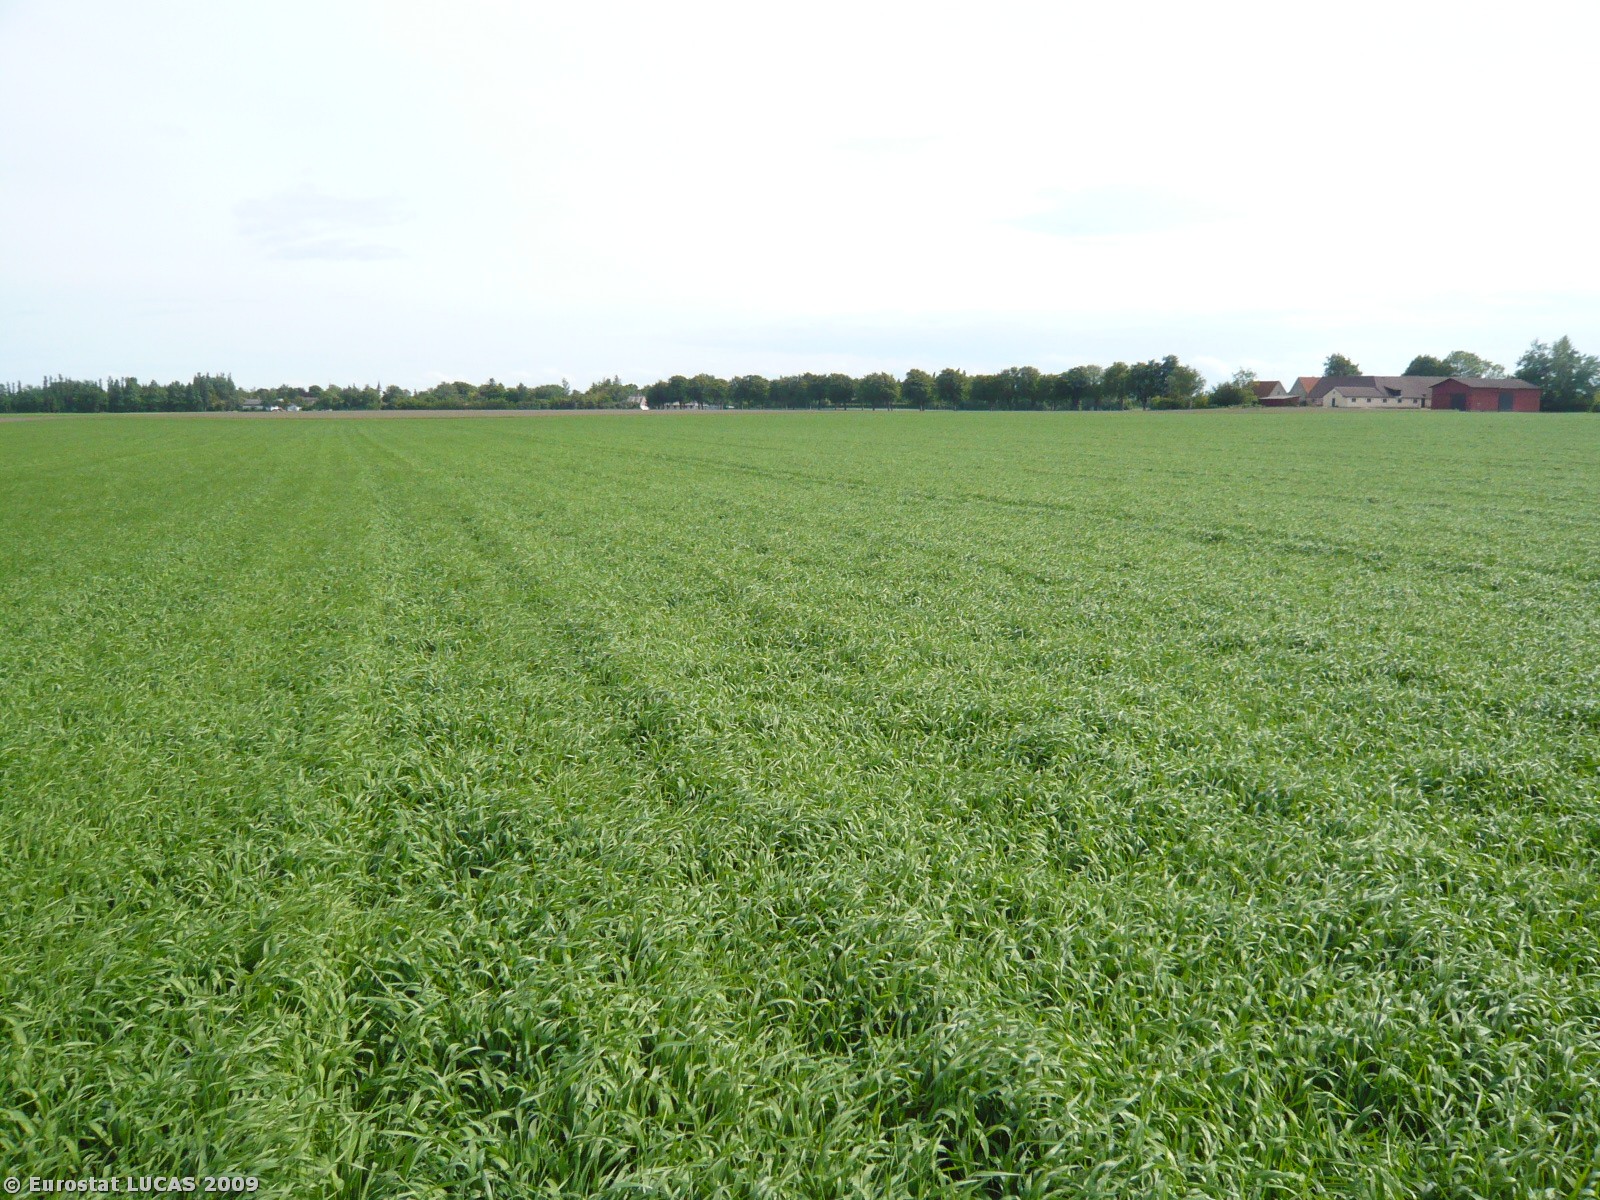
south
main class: Cropland
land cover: Barley
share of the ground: > 75 %
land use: Agriculture (excluding fallow land and kitchen gardens)
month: June
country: DK
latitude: 54.6090
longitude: 11.9342
